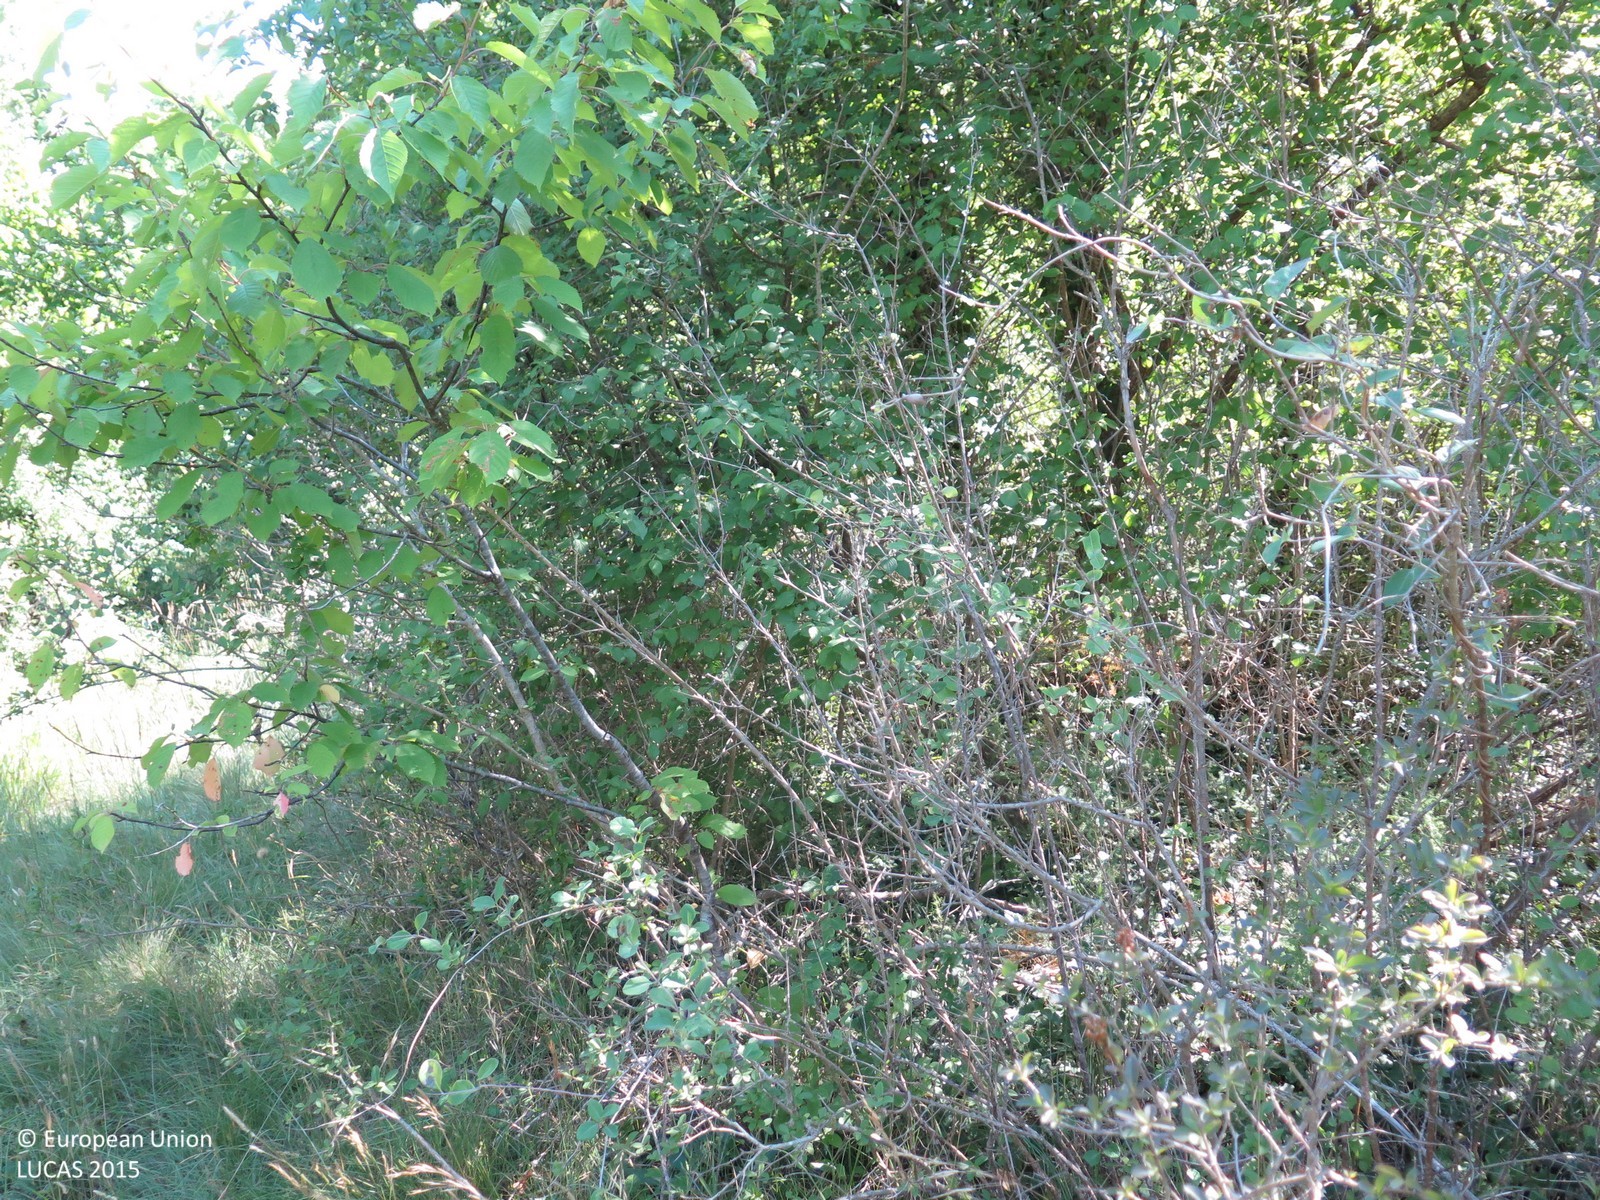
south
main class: Woodland
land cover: Broadleaved woodland
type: mesophytic deciduous forest
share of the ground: > 75 %
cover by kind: broadleaved forest trees 90 %, shrubs 5 %, herbaceous plants 5 %
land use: Semi-natural and natural areas not in use
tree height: > 5 m
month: June
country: HR
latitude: 45.2393
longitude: 13.7529
